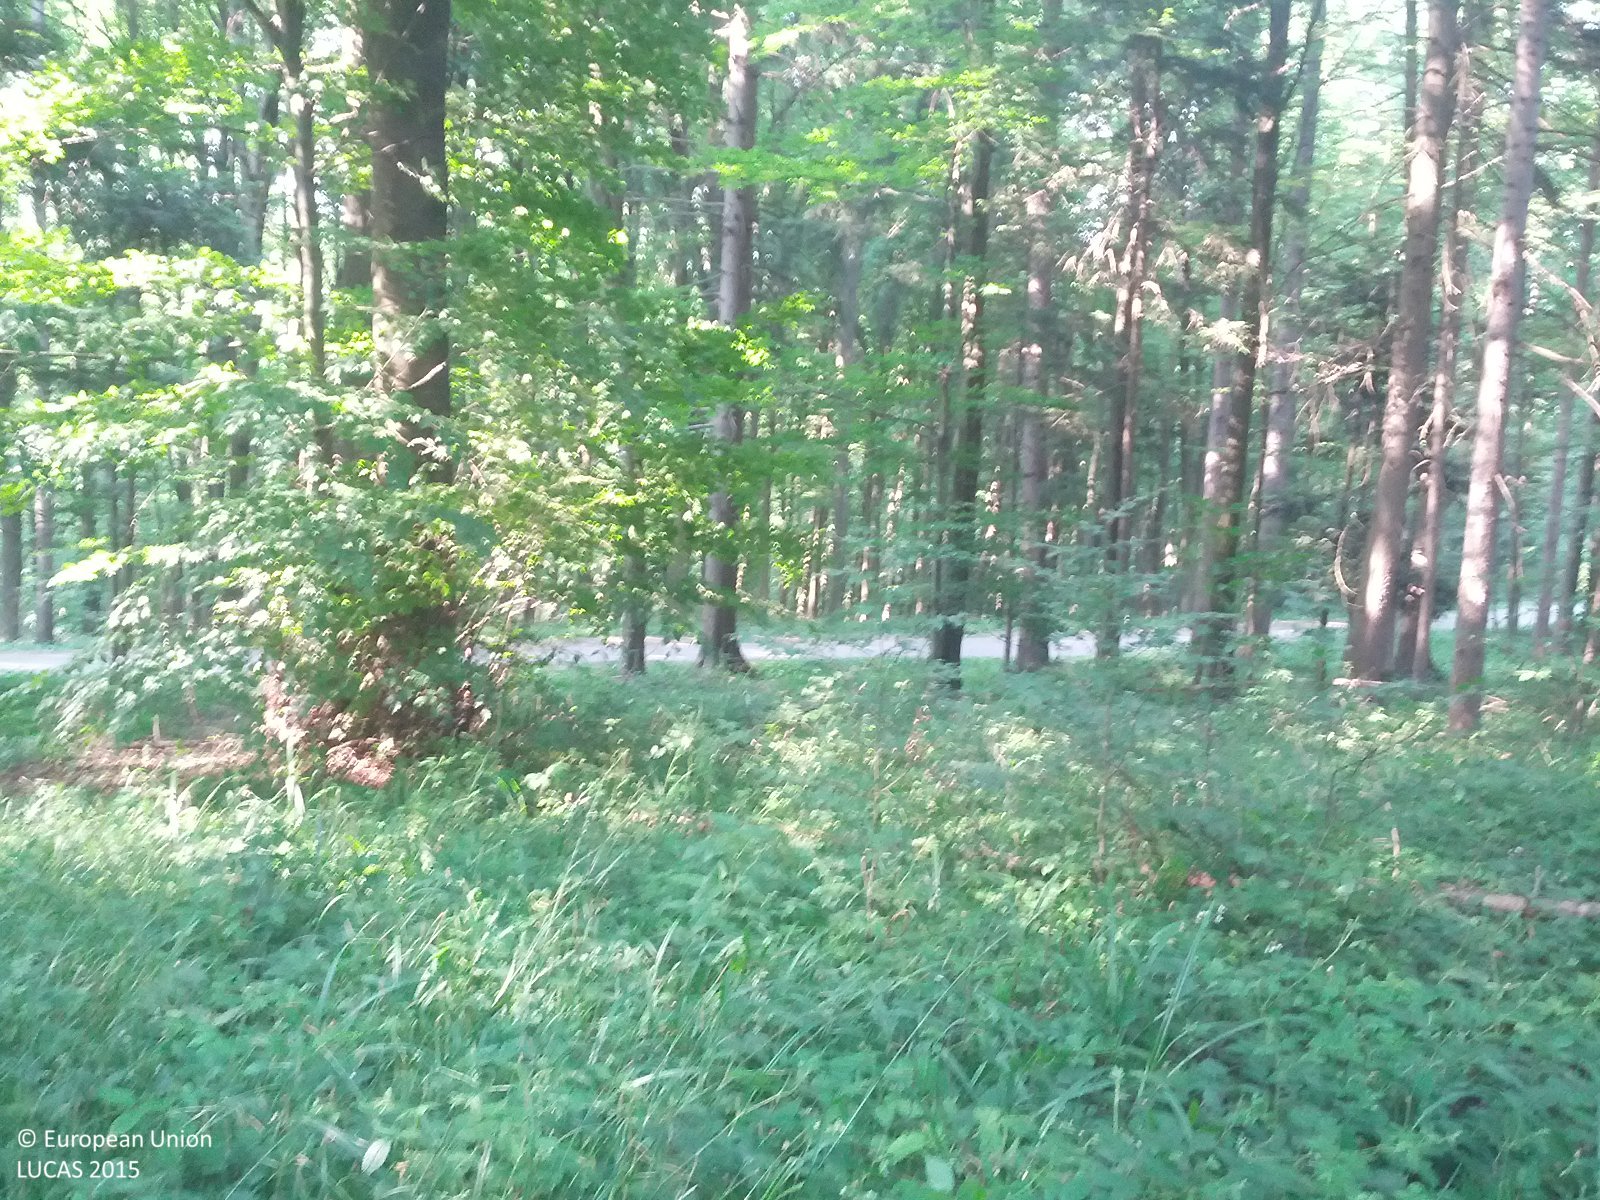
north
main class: Woodland
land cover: Spruce dominated mixed woodland
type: alpine coniferous forest
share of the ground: > 75 %
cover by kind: coniferous forest trees 60 %, broadleaved forest trees 30 %, herbaceous plants 5 %, lichens and mosses 5 %
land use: Forestry
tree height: > 5 m
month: June
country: AT
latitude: 48.1647
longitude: 16.0677
